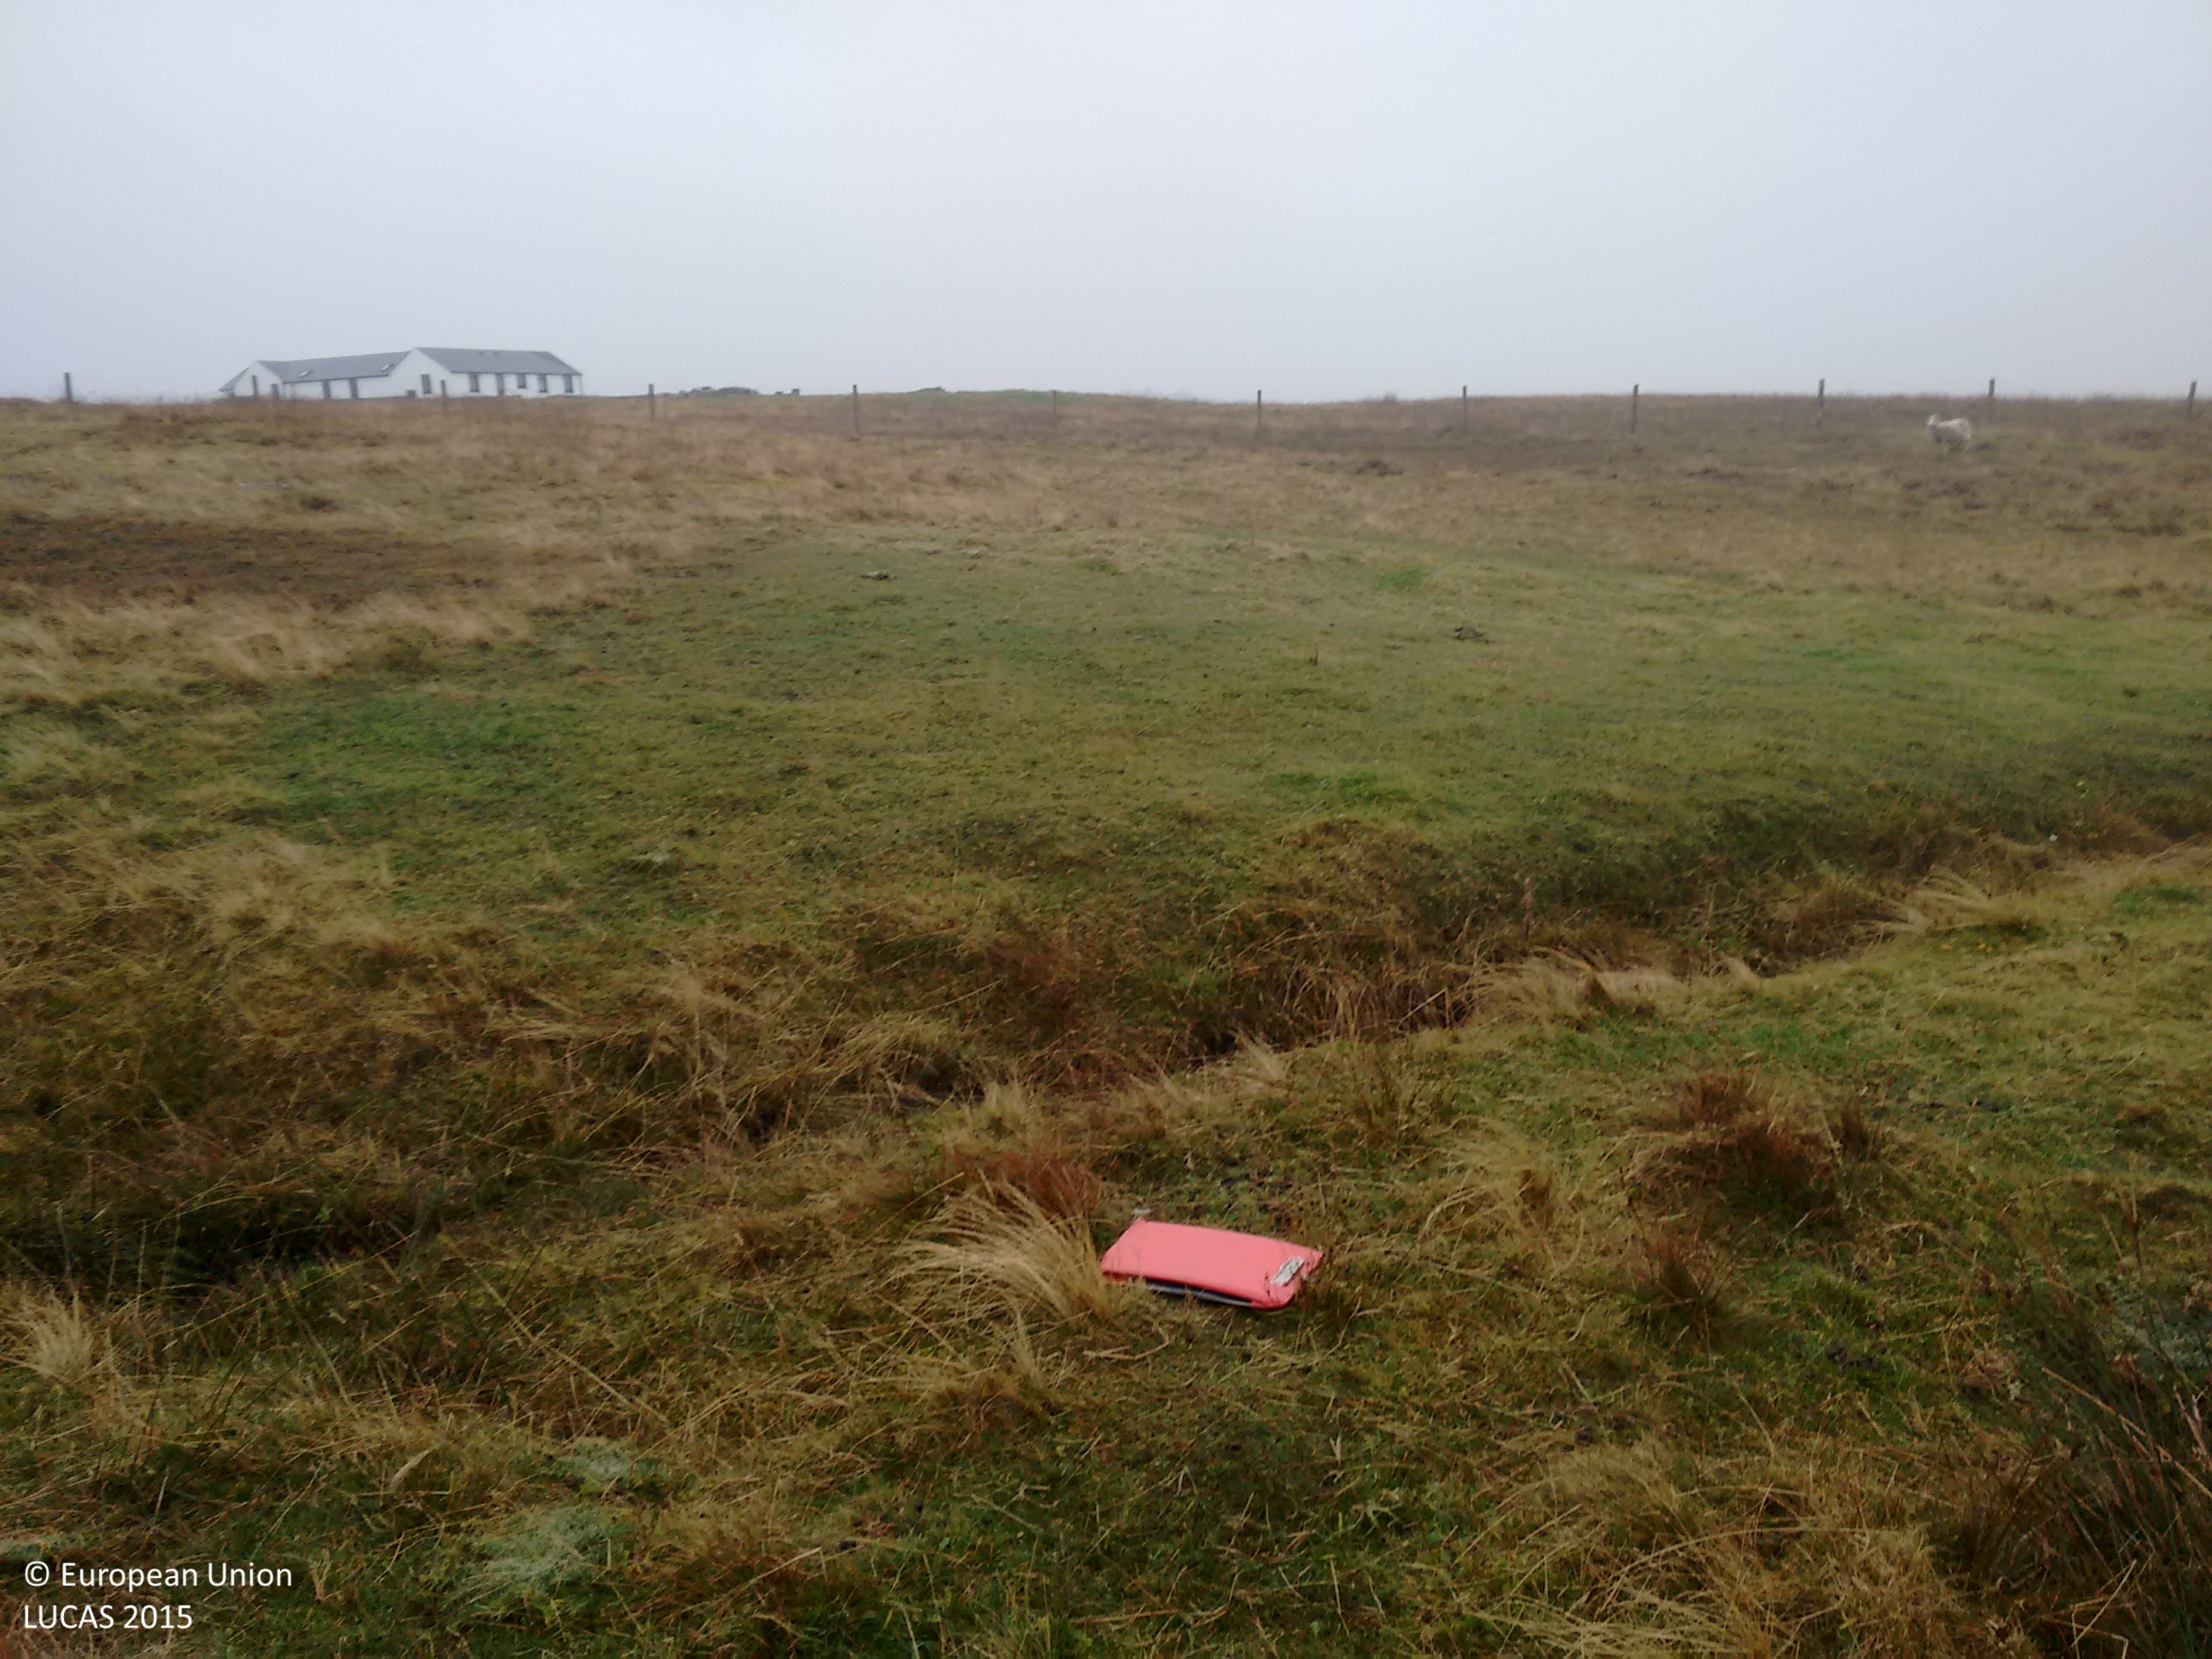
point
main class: Grassland
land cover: Grassland without tree/shrub cover
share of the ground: > 75 %
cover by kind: herbaceous plants 100 %
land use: Agriculture (excluding fallow land and kitchen gardens)
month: November
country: GB
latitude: 60.3551
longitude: -1.1641
